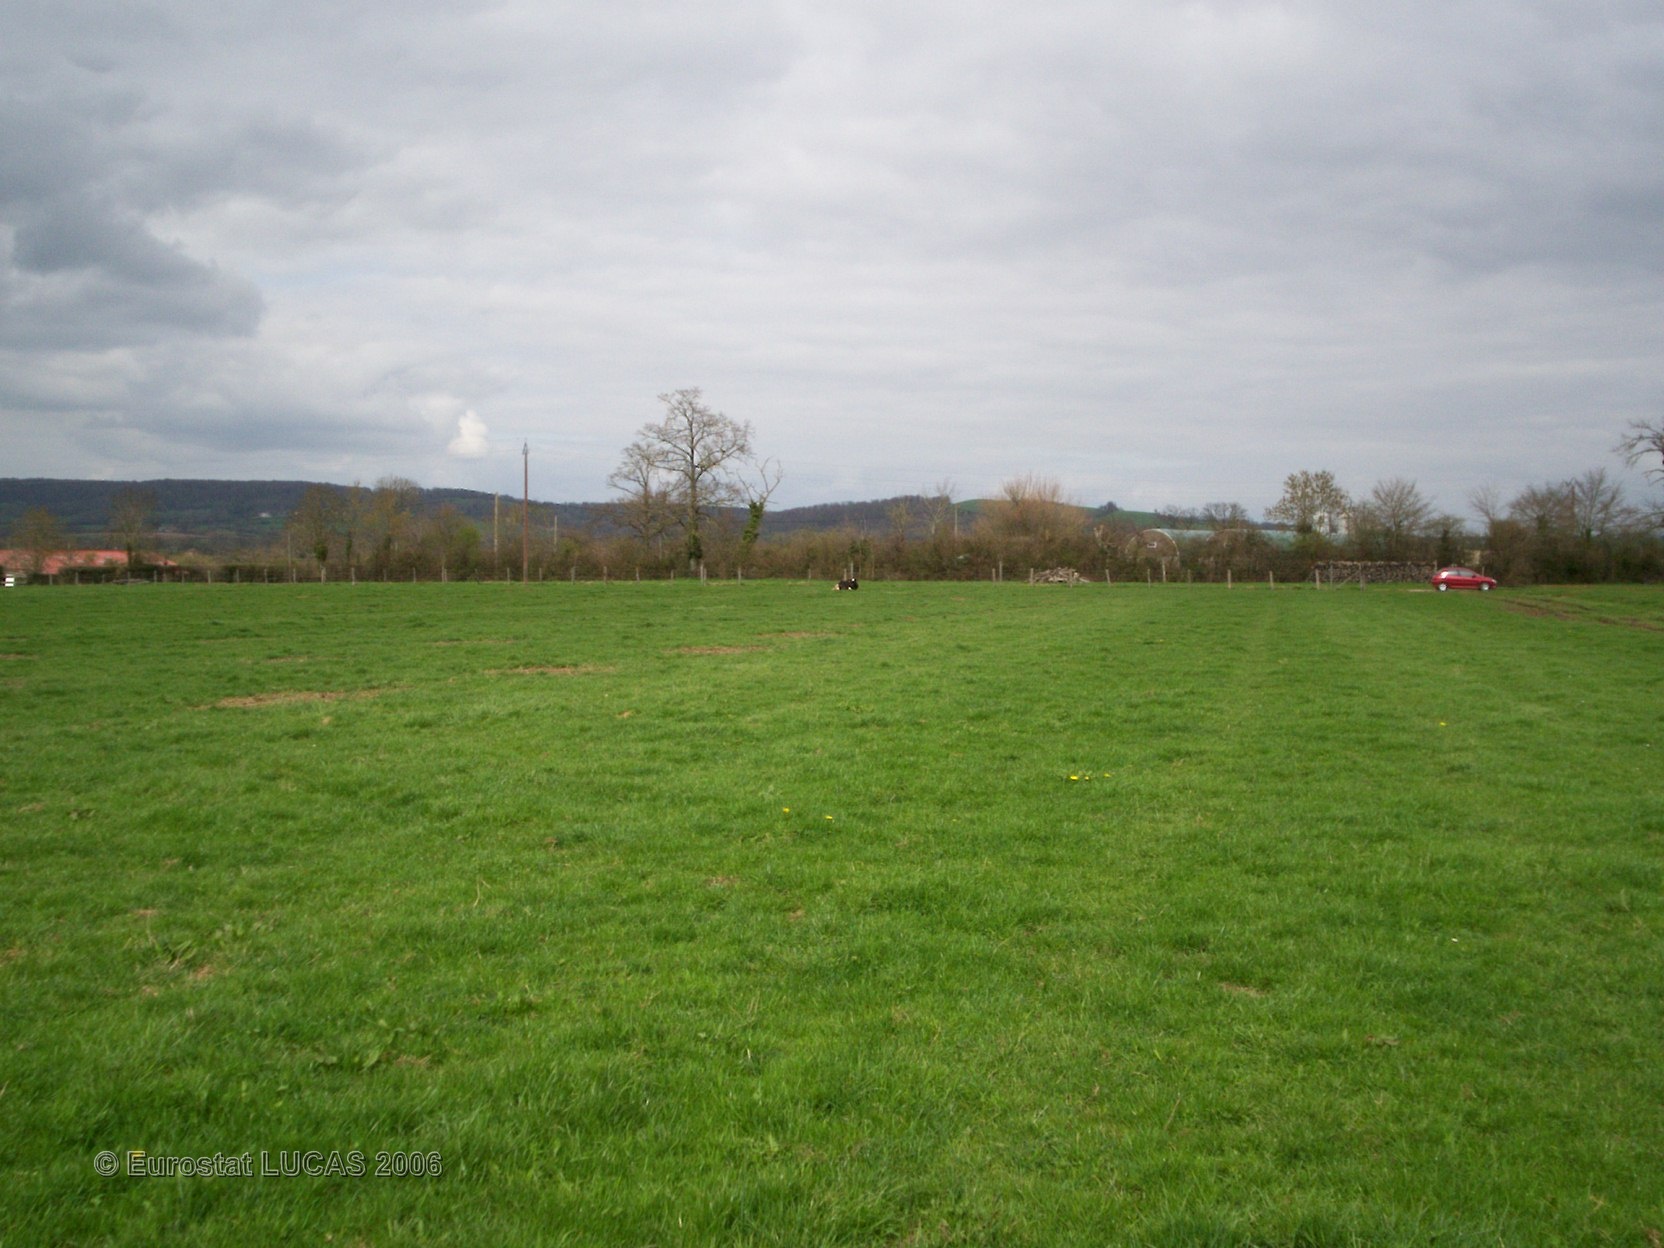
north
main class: Grassland
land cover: Grassland without tree/shrub cover
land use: Agriculture (excluding fallow land and kitchen gardens)
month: April
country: FR
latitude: 48.8455
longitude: 0.0912
